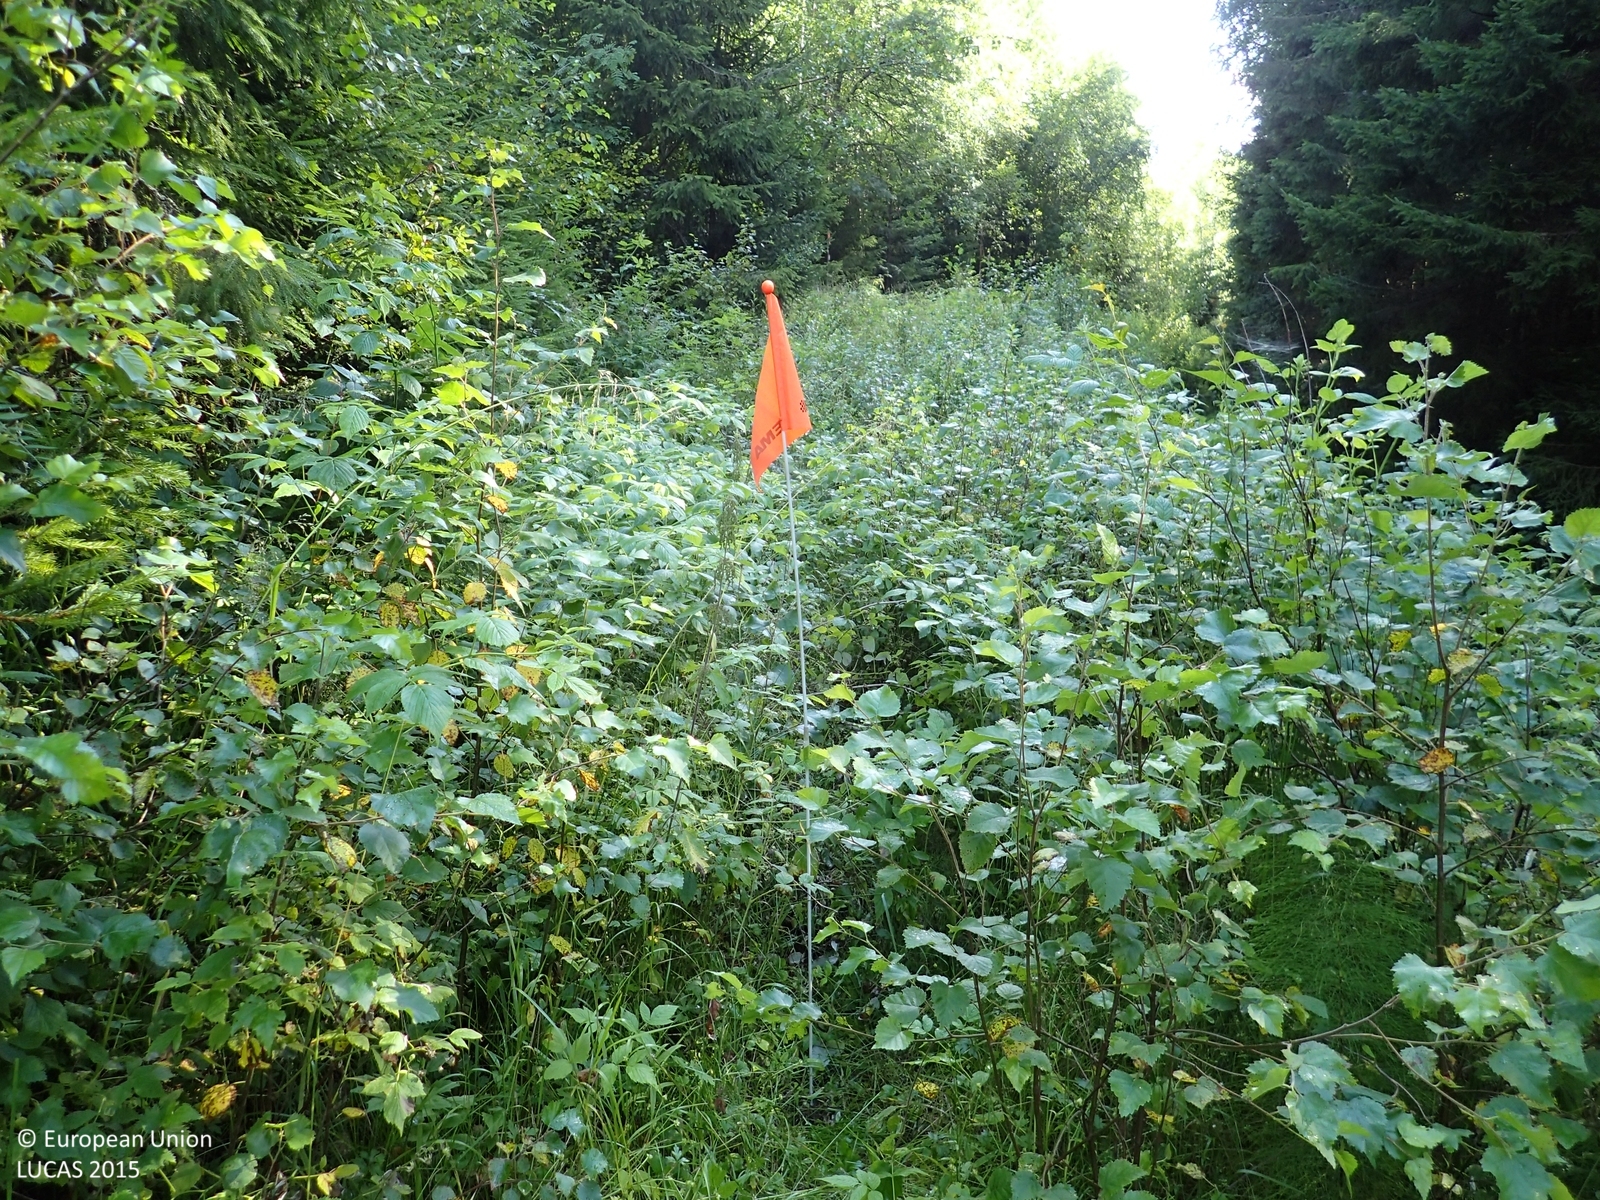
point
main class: Woodland
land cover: Broadleaved woodland
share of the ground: 25 - 50 %
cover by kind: herbaceous plants 75 %, broadleaved forest trees 25 %
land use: Forestry
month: August
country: FI
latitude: 62.9676
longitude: 21.8172
